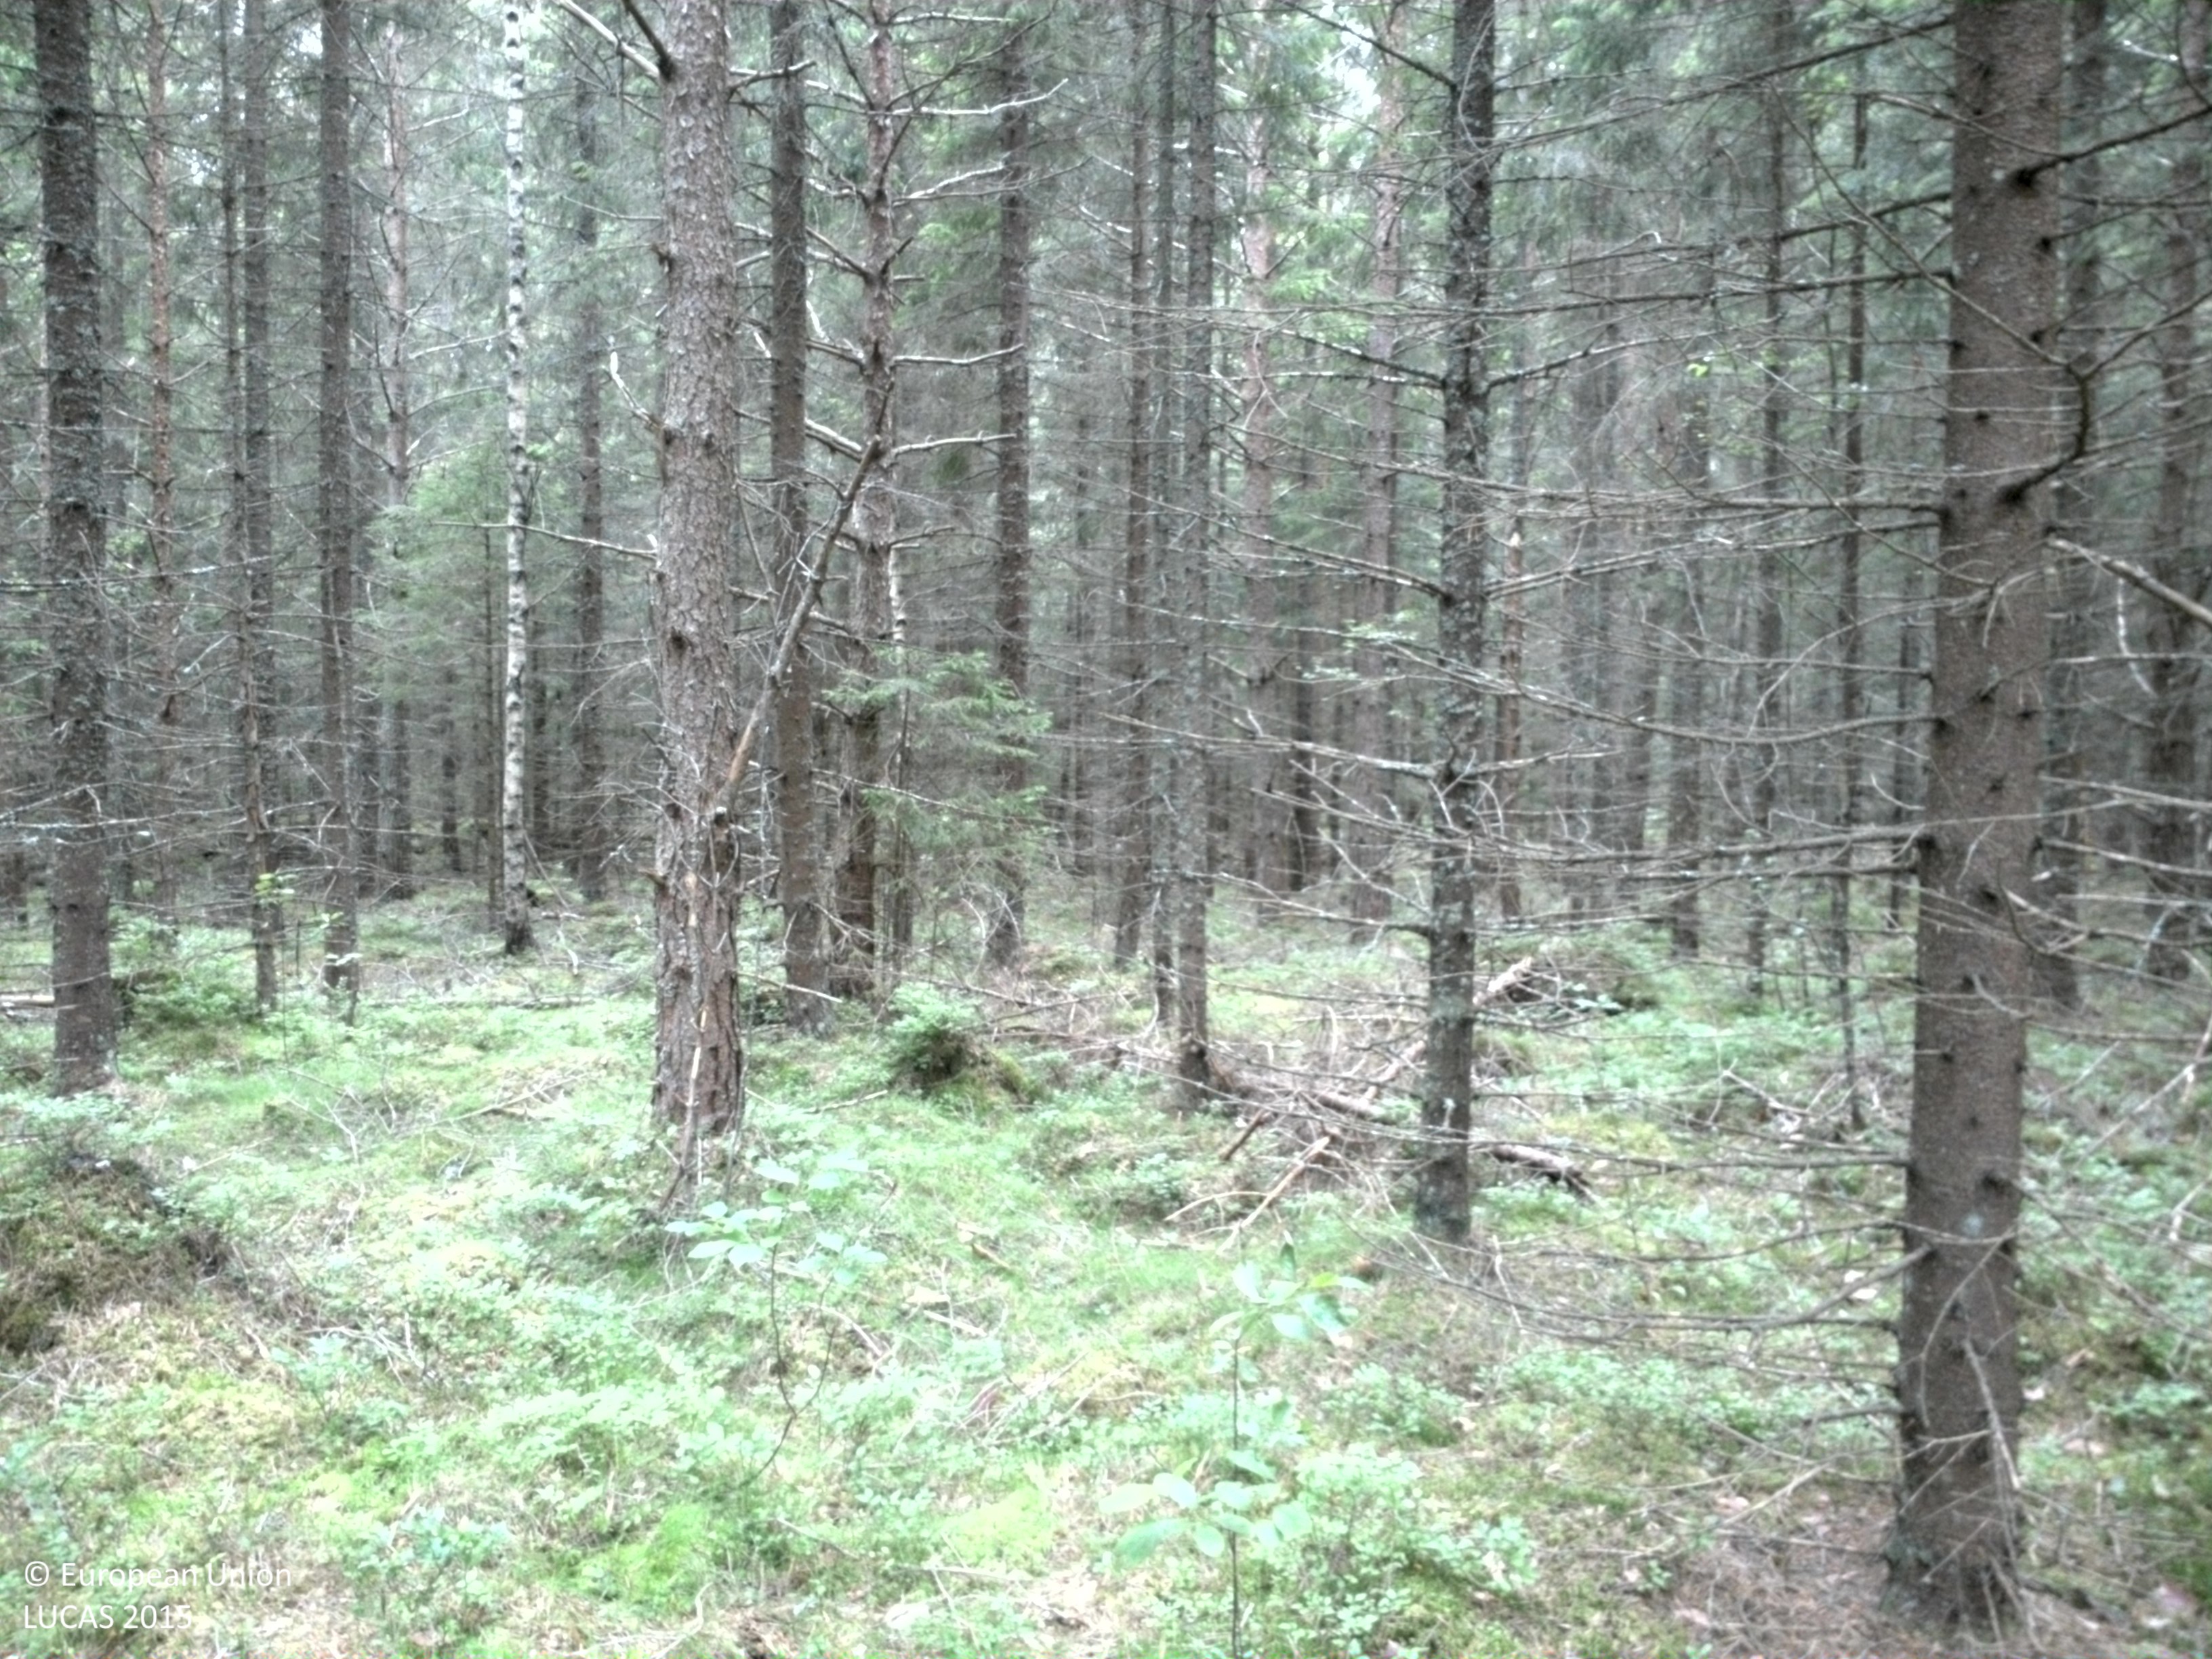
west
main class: Woodland
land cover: Other coniferous woodland
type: boreal forest
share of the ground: 25 - 50 %
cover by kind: coniferous forest trees 45 %, herbaceous plants 35 %, lichens and mosses 20 %
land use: Forestry
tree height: > 5 m
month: July
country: SE
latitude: 58.9385
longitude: 14.4582
